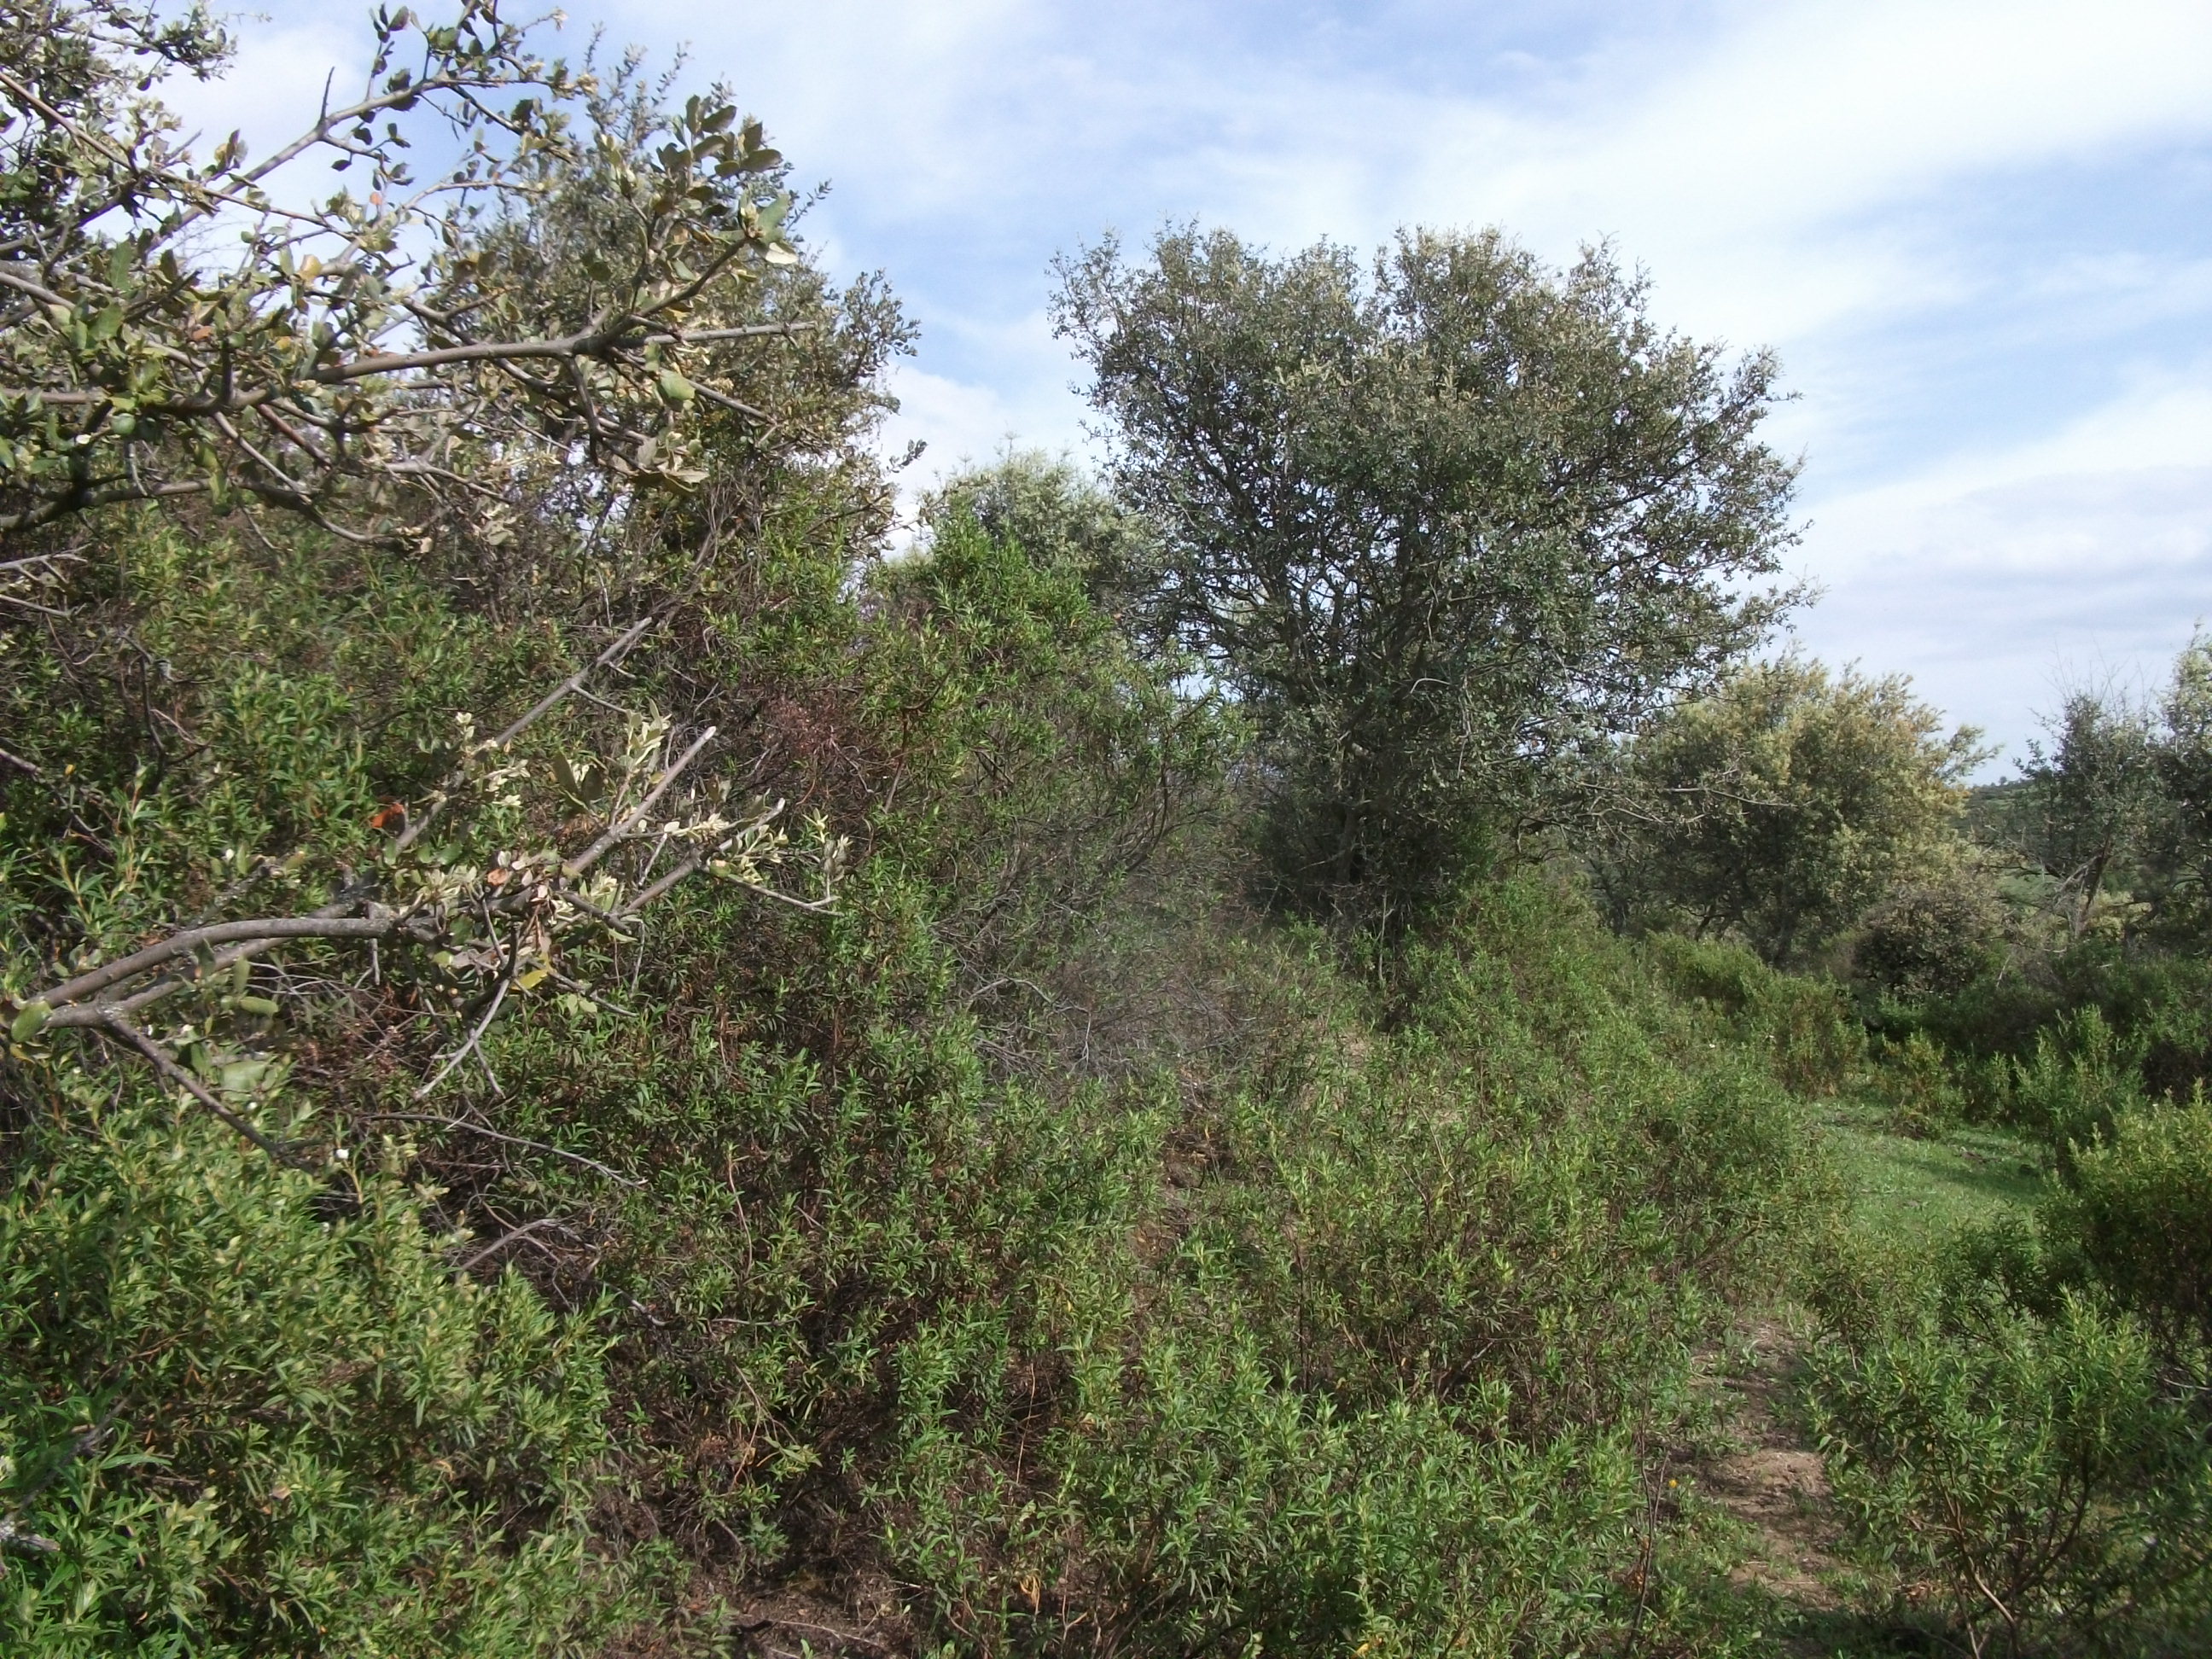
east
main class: Woodland
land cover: Broadleaved woodland
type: broadleaved evergreen forest
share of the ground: 25 - 50 %
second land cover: Shrubland without tree cover
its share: 25 - 50 %
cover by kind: shrubs 40 %, broadleaved forest trees 30 %, herbaceous plants 30 %
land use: Forestry
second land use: Agriculture (excluding fallow land and kitchen gardens)
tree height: < 5 m
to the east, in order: Broadleaved woodland; Shrubland without tree cover
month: April
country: ES
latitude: 37.8834
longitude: -6.4942
